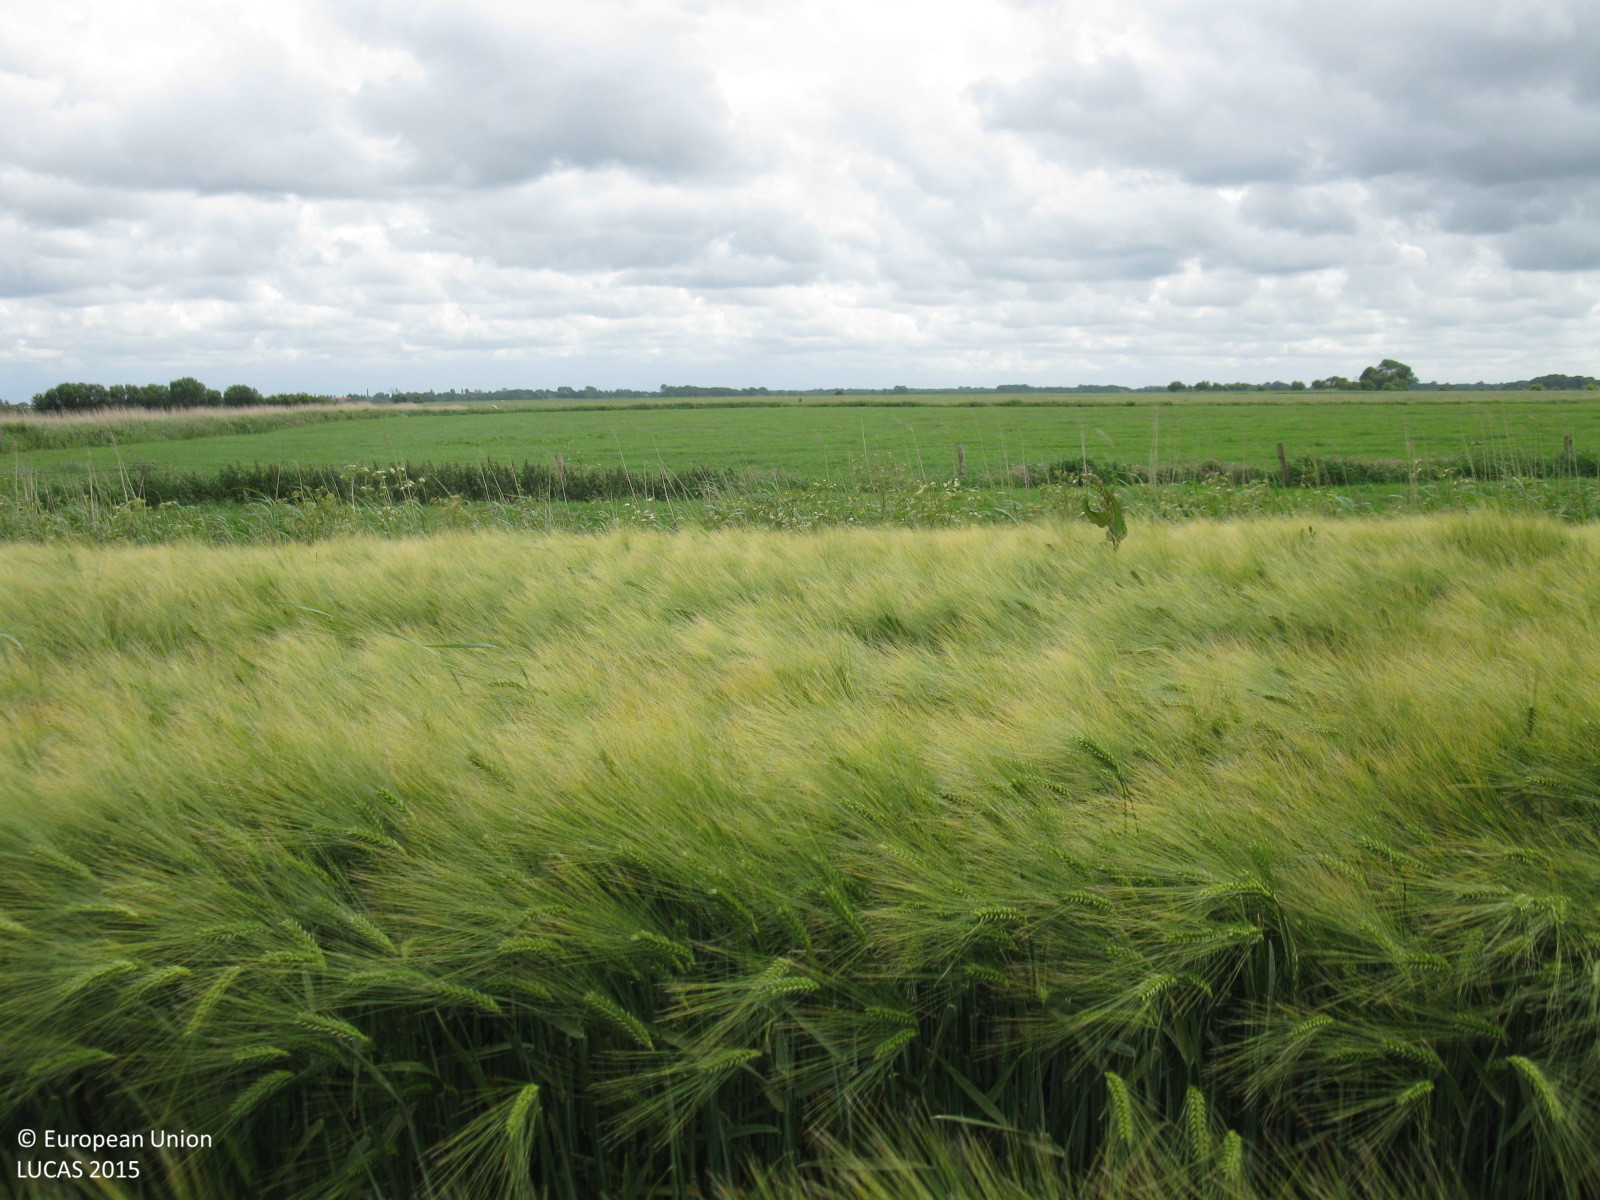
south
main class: Cropland
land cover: Barley
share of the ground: > 75 %
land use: Agriculture (excluding fallow land and kitchen gardens)
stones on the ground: < 10 %
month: June
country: DE
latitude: 53.6428
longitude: 7.3536
